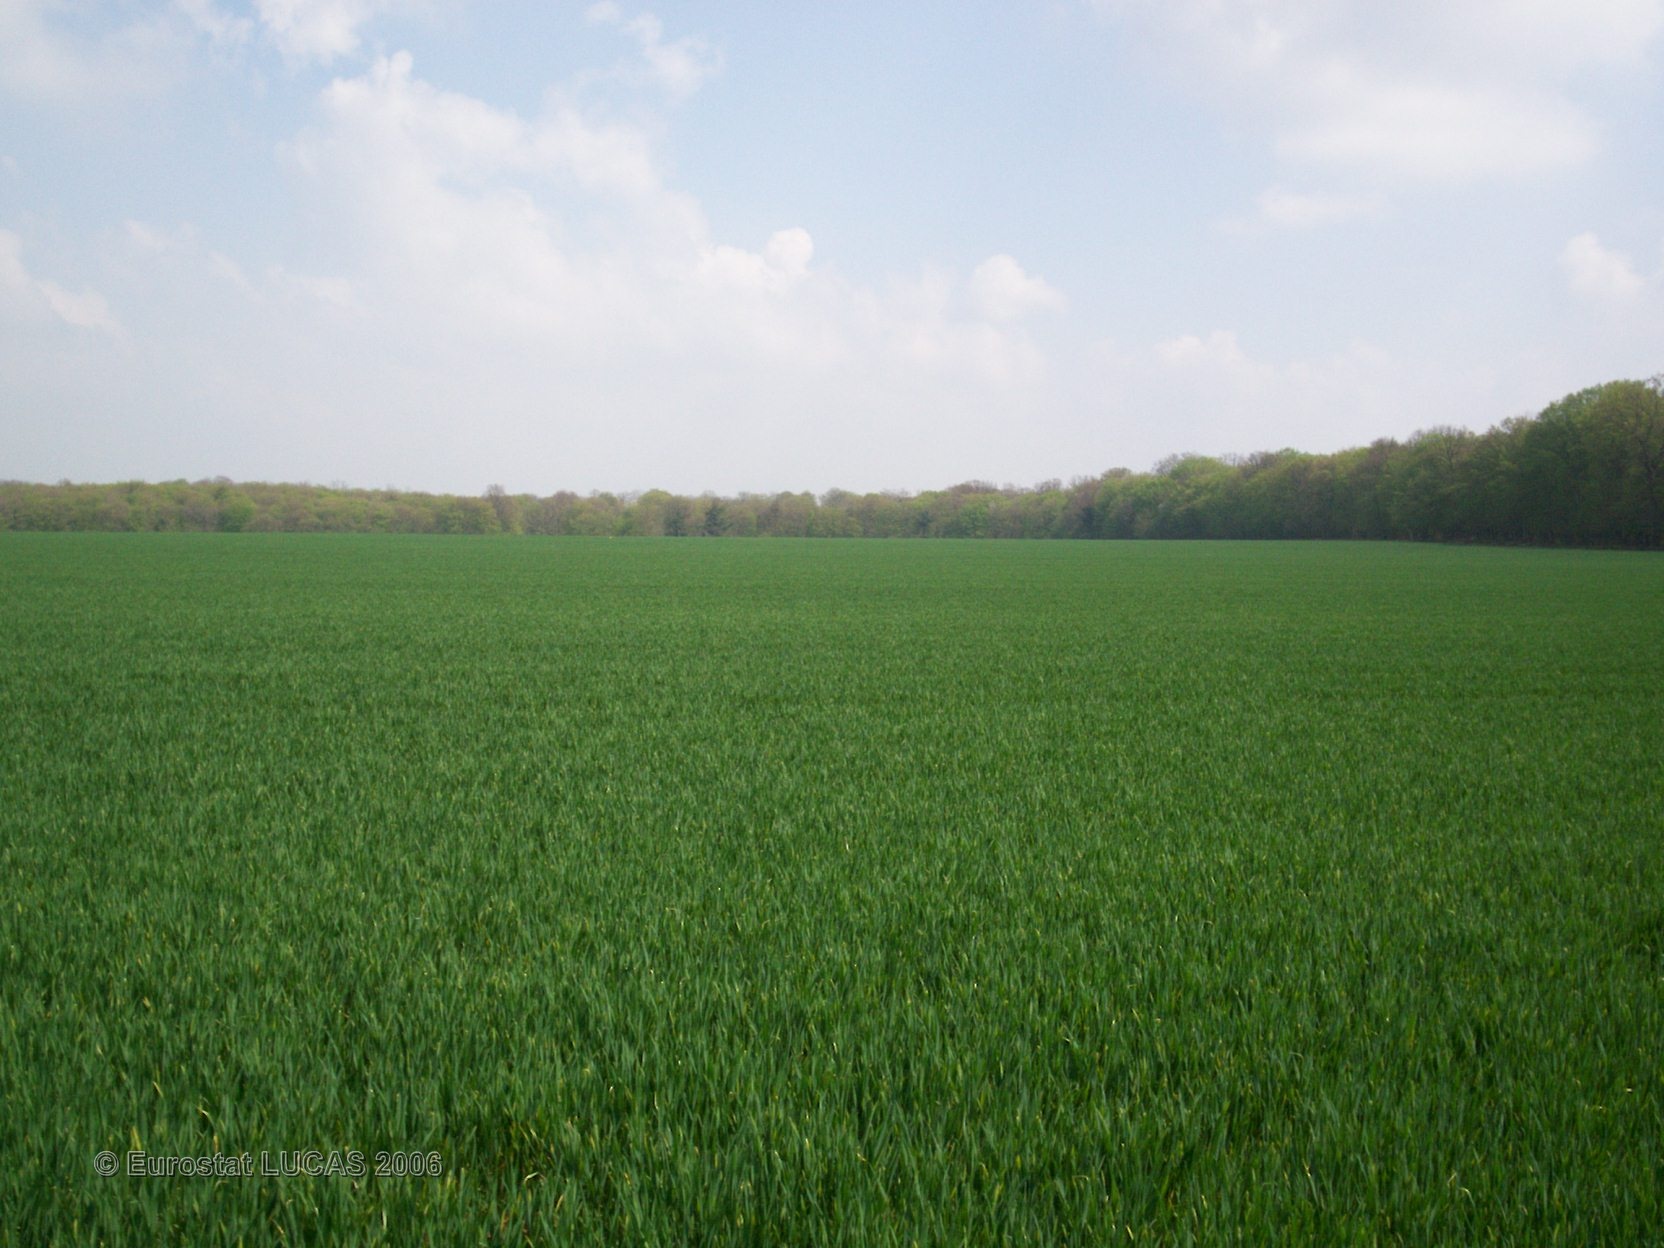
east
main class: Cropland
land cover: Common wheat
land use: Agriculture (excluding fallow land and kitchen gardens)
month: April
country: FR
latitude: 48.0366
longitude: 4.9695
